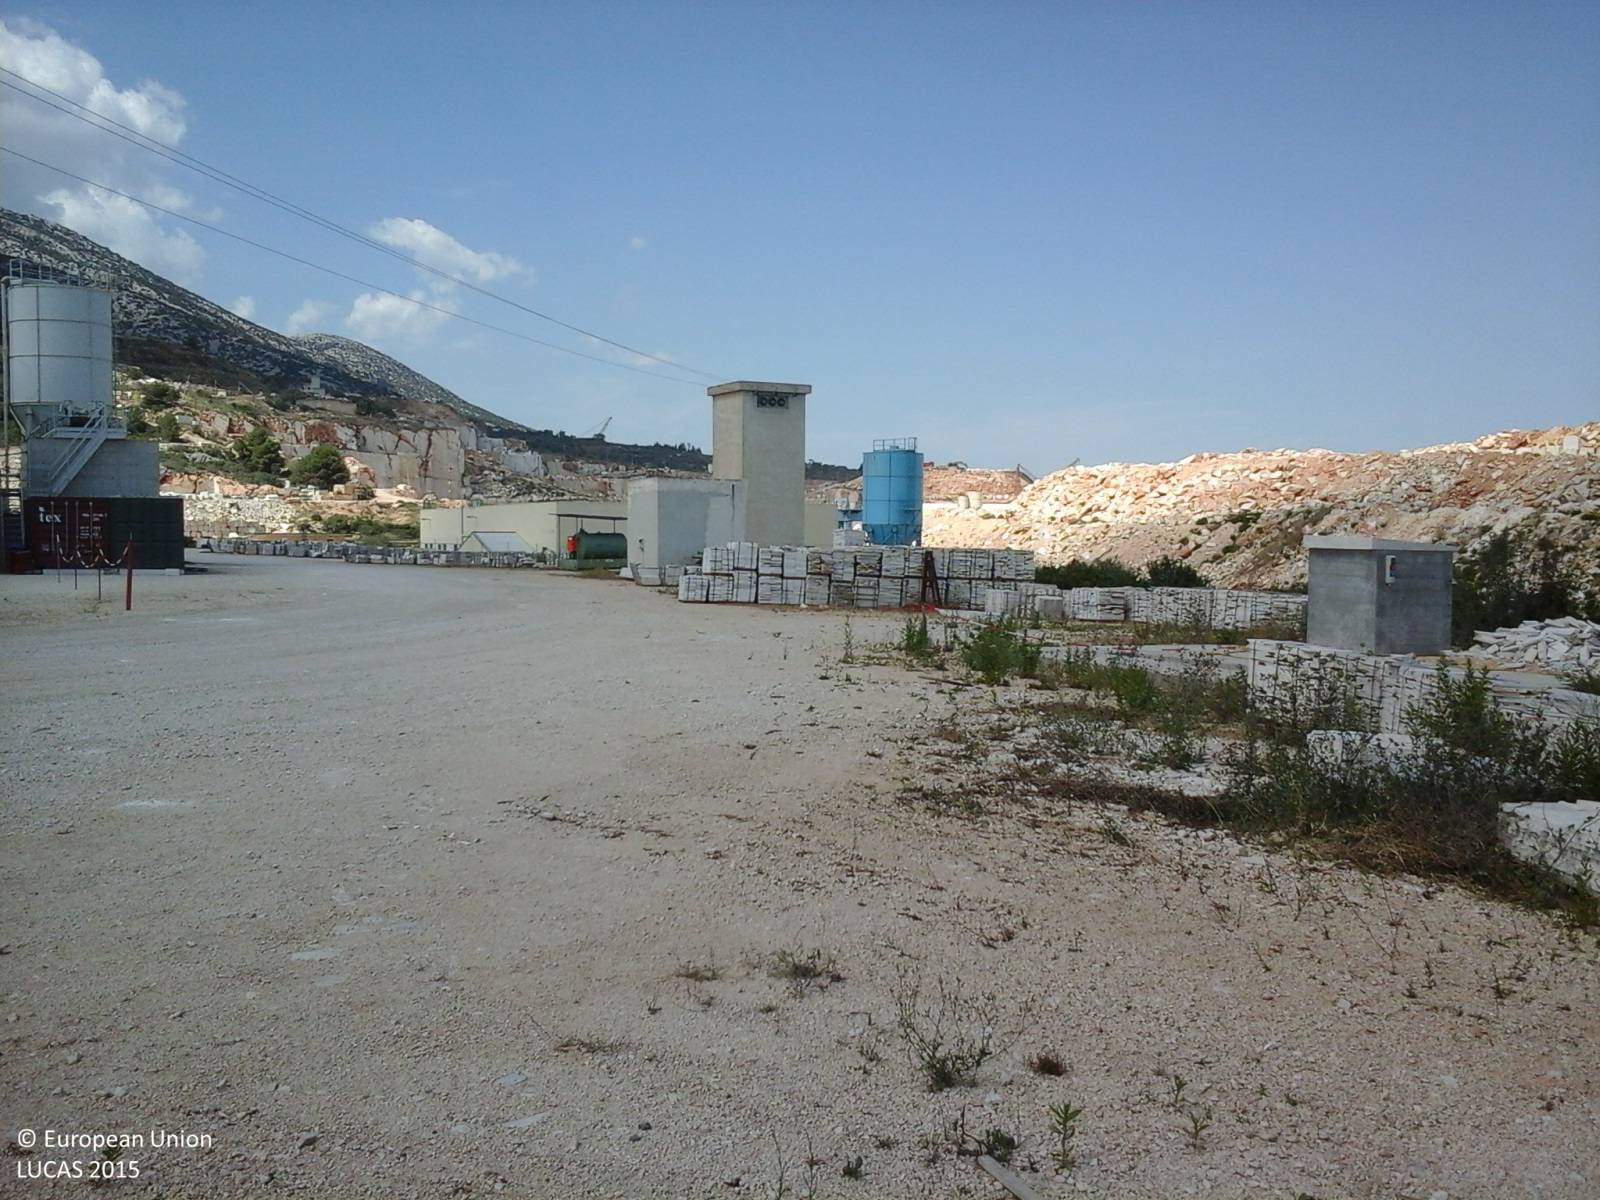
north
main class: Woodland
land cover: Broadleaved woodland
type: broadleaved evergreen forest
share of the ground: > 75 %
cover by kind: broadleaved forest trees 95 %, shrubs 5 %
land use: Forestry
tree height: > 5 m
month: June
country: IT
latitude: 40.3573
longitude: 9.6603
